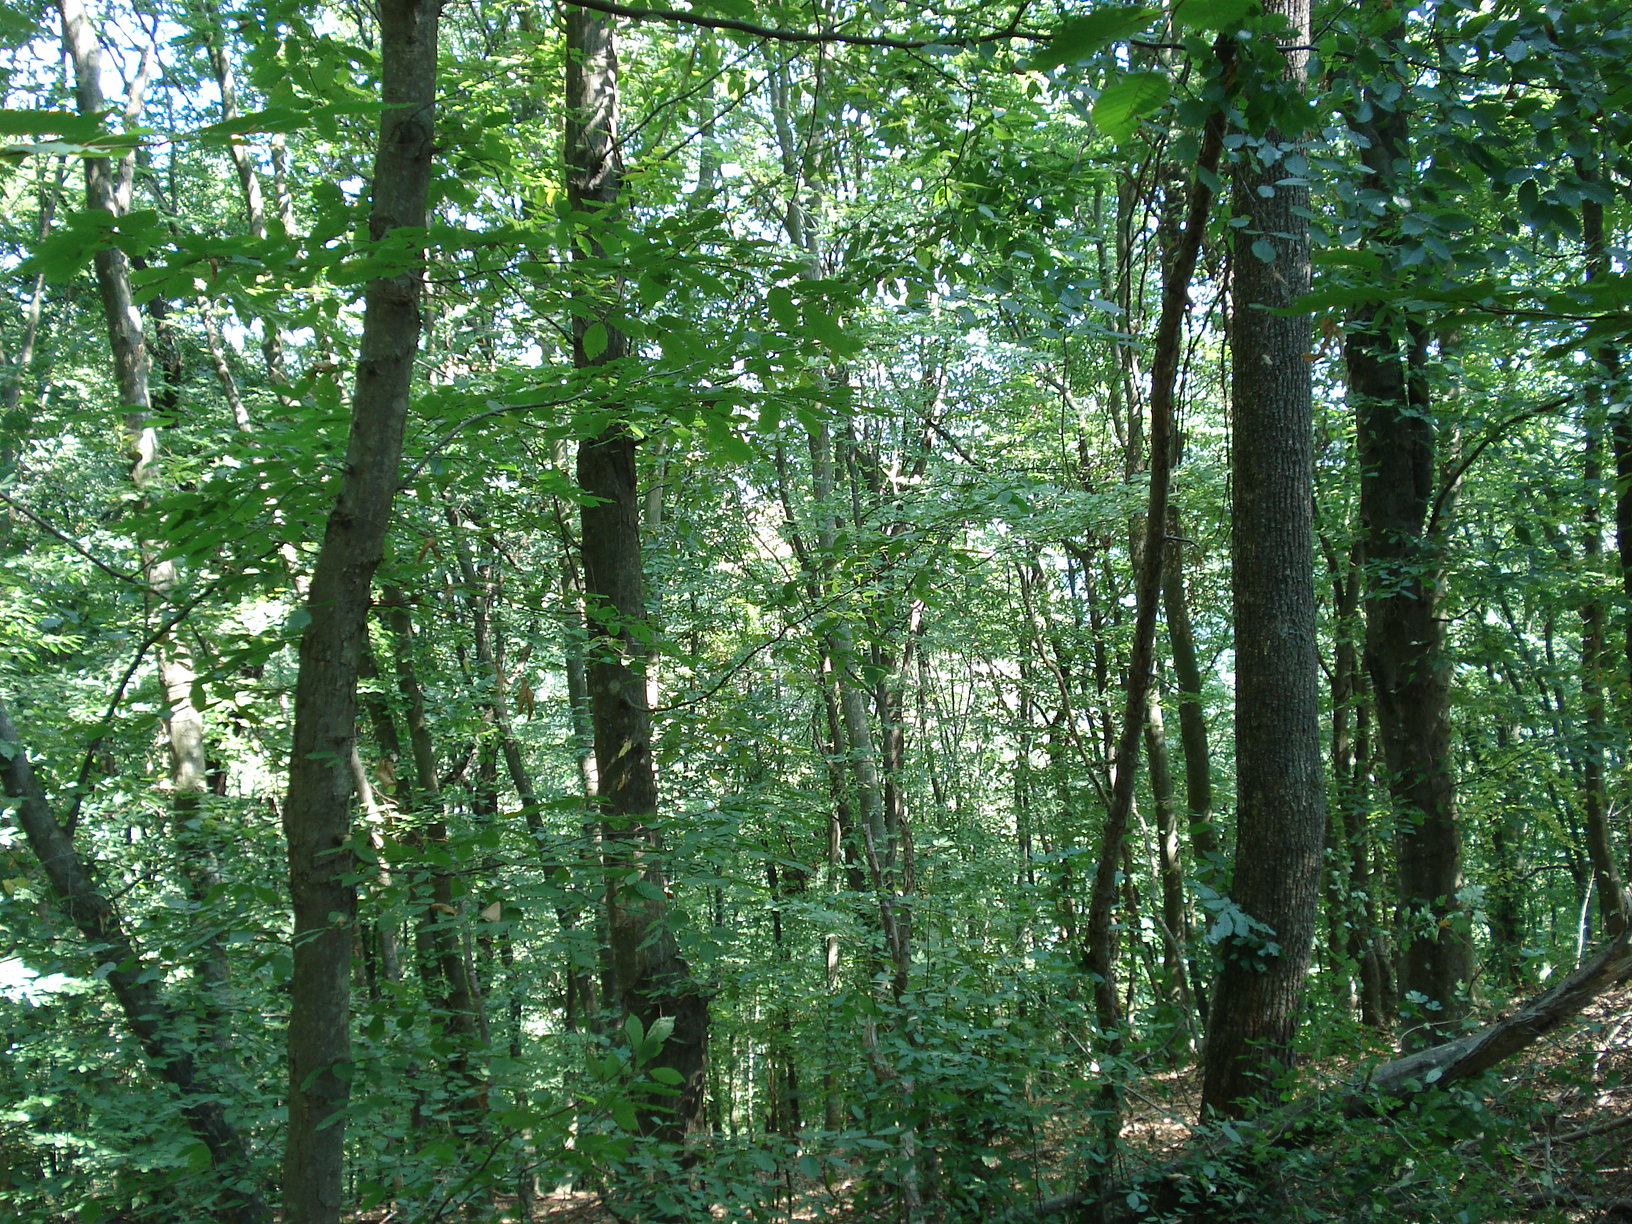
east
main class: Woodland
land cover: Broadleaved woodland
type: beech forest
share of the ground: > 75 %
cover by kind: broadleaved forest trees 80 %, unconsolidated bare surface 20 %
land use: Forestry
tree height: > 5 m
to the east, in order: Broadleaved woodland; Inland fresh running water; Broadleaved woodland; Inland fresh running water; Broadleaved woodland
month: September
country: BG
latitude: 43.2110
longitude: 26.1057
